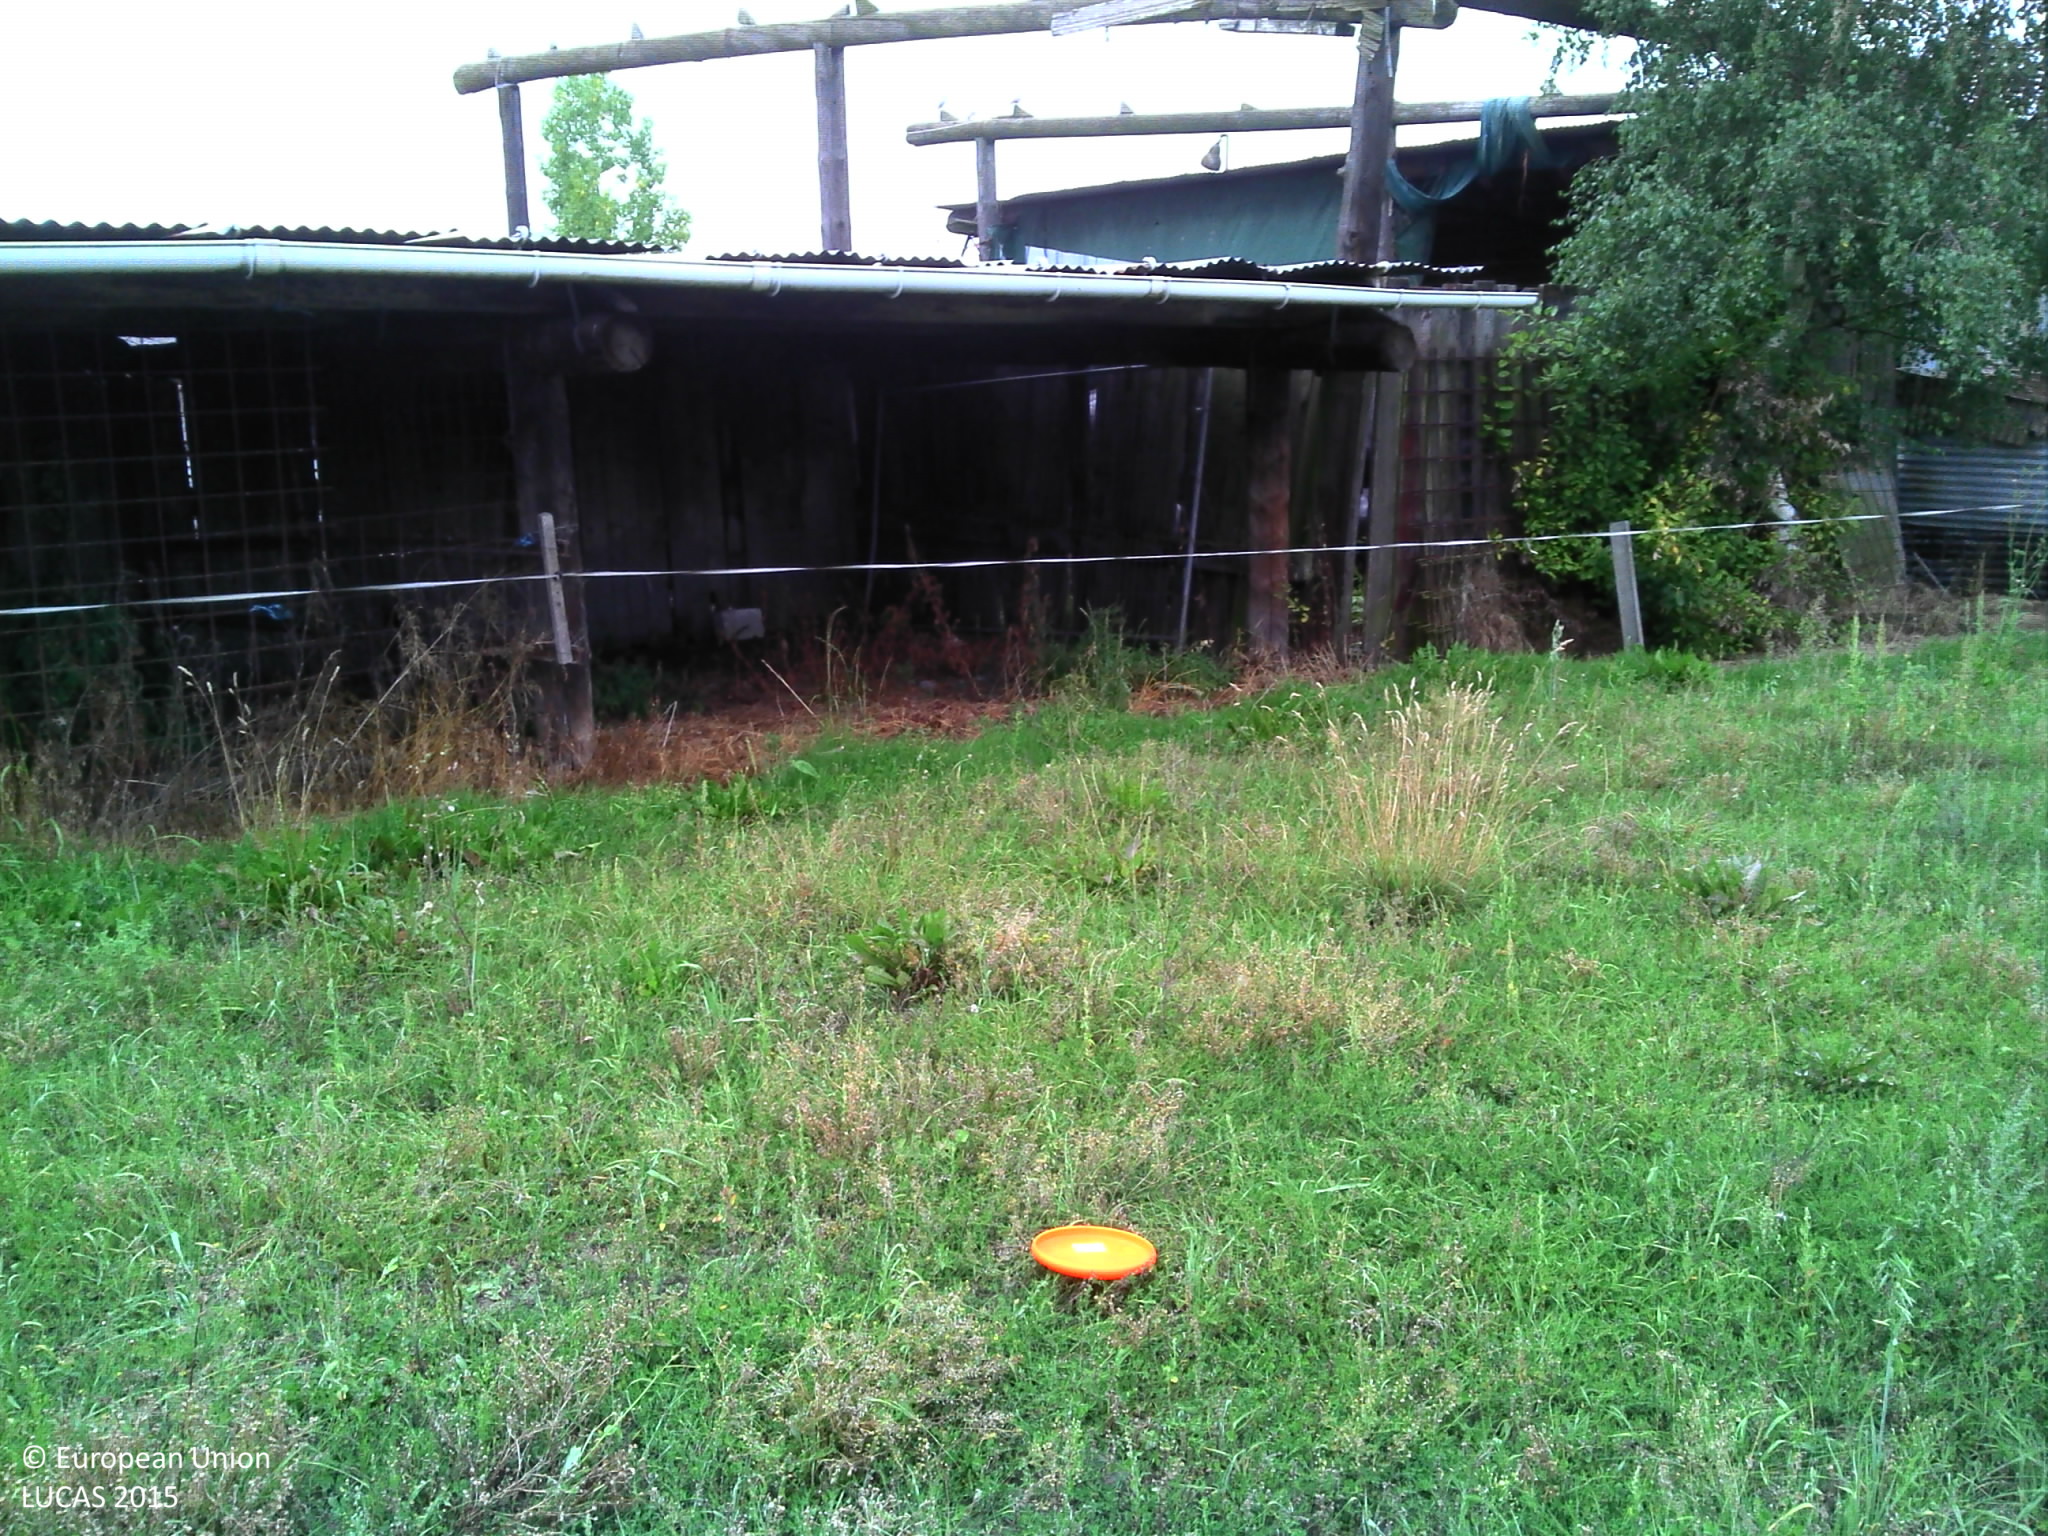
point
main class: Grassland
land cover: Grassland without tree/shrub cover
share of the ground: > 75 %
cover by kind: herbaceous plants 100 %
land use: Agriculture (excluding fallow land and kitchen gardens)
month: August
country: BE
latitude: 50.6863
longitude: 3.8649
